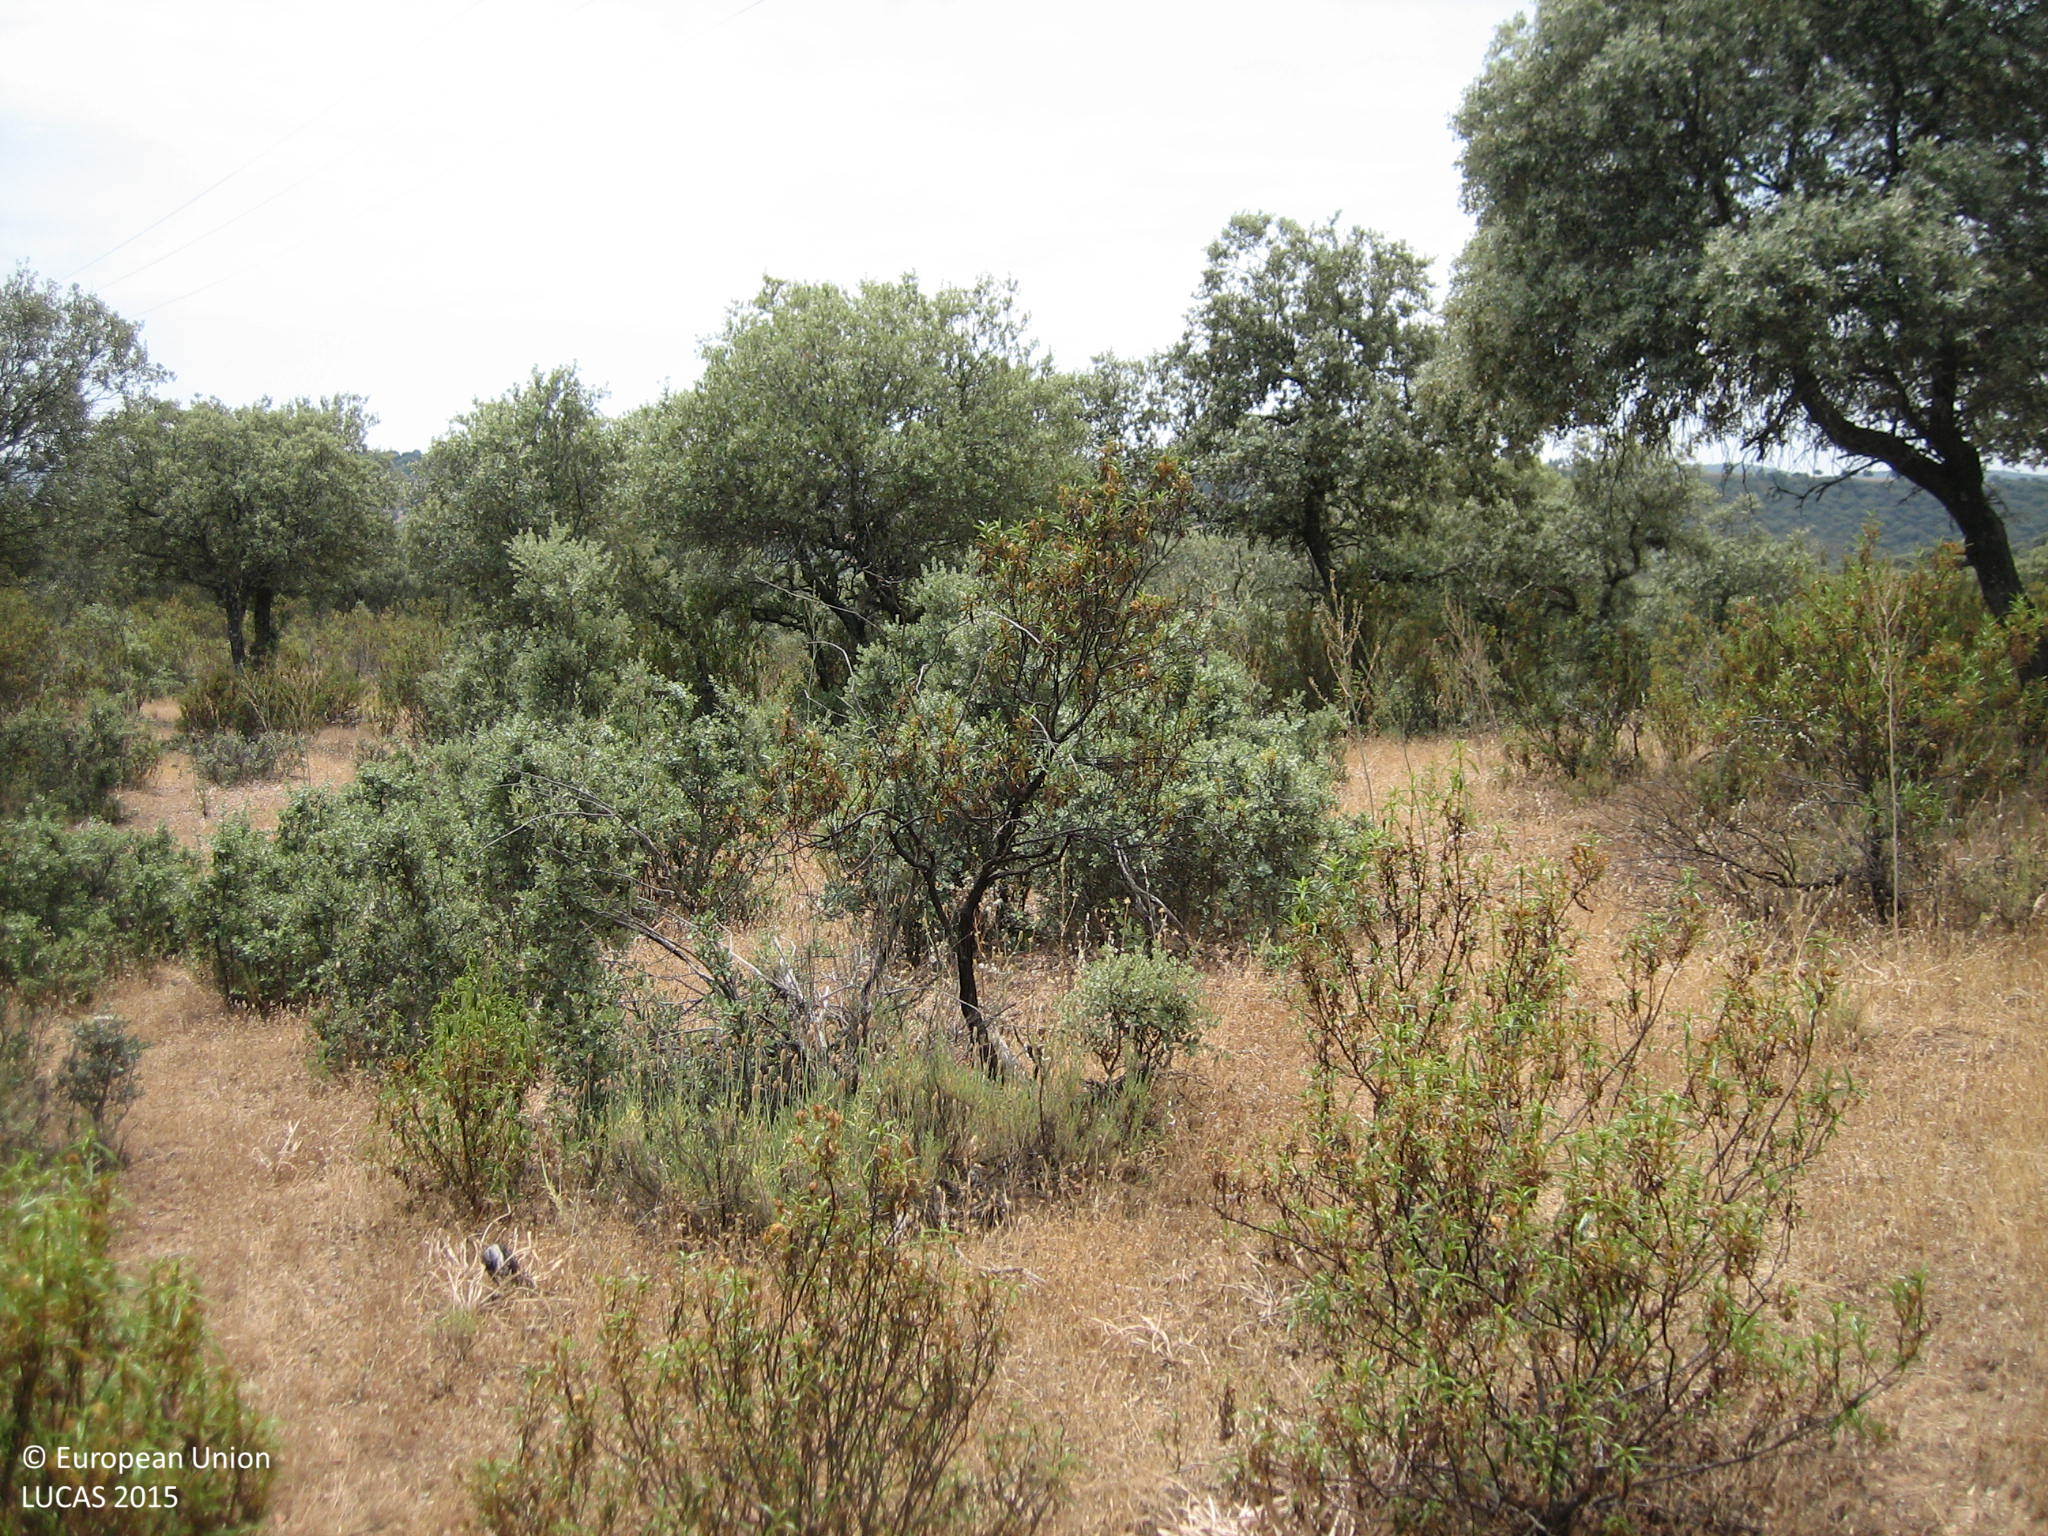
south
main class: Shrubland
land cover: Shrubland with sparse tree cover
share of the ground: 50 - 75 %
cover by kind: herbaceous plants 55 %, shrubs 40 %, broadleaved forest trees 5 %
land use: Semi-natural and natural areas not in use
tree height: > 5 m
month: June
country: ES
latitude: 39.1961
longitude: -4.5400
